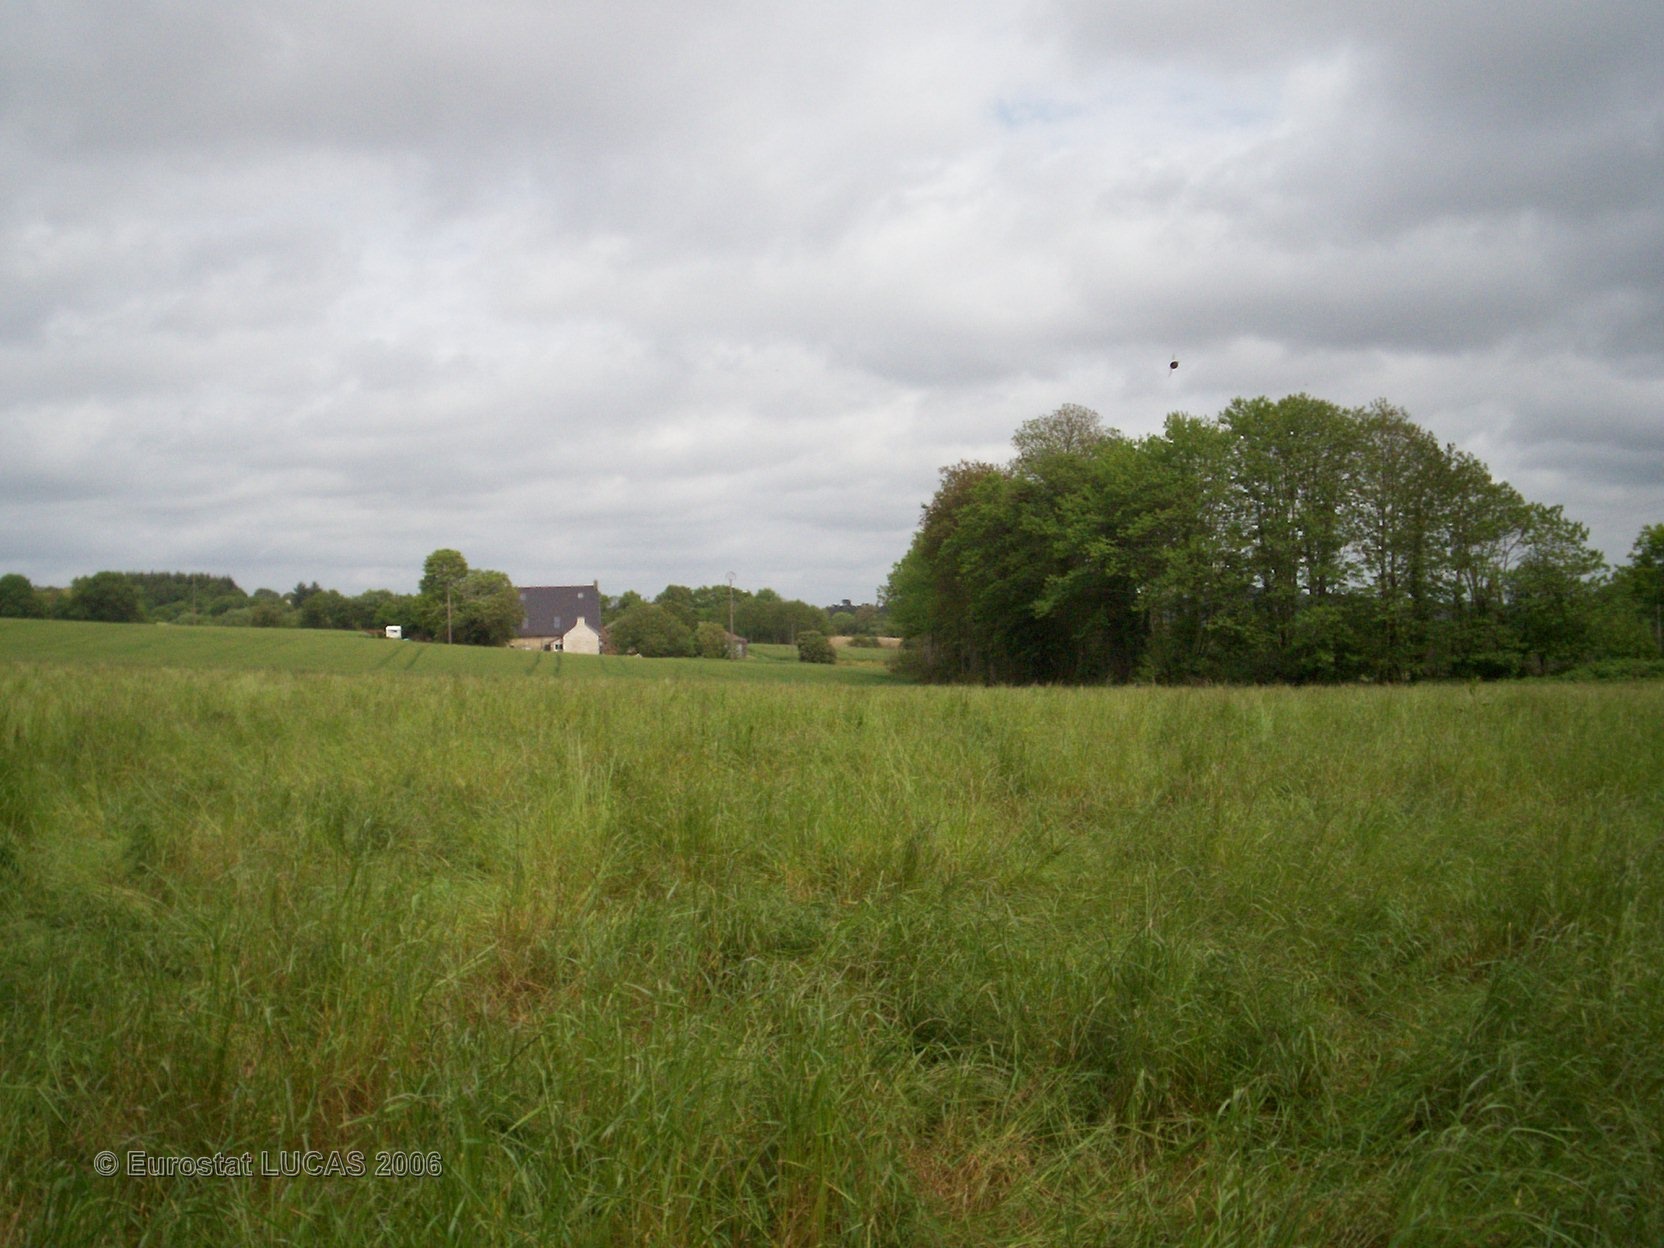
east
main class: Grassland
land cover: Grassland without tree/shrub cover
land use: Agriculture (excluding fallow land and kitchen gardens)
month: May
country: FR
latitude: 47.9145
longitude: -3.5240
